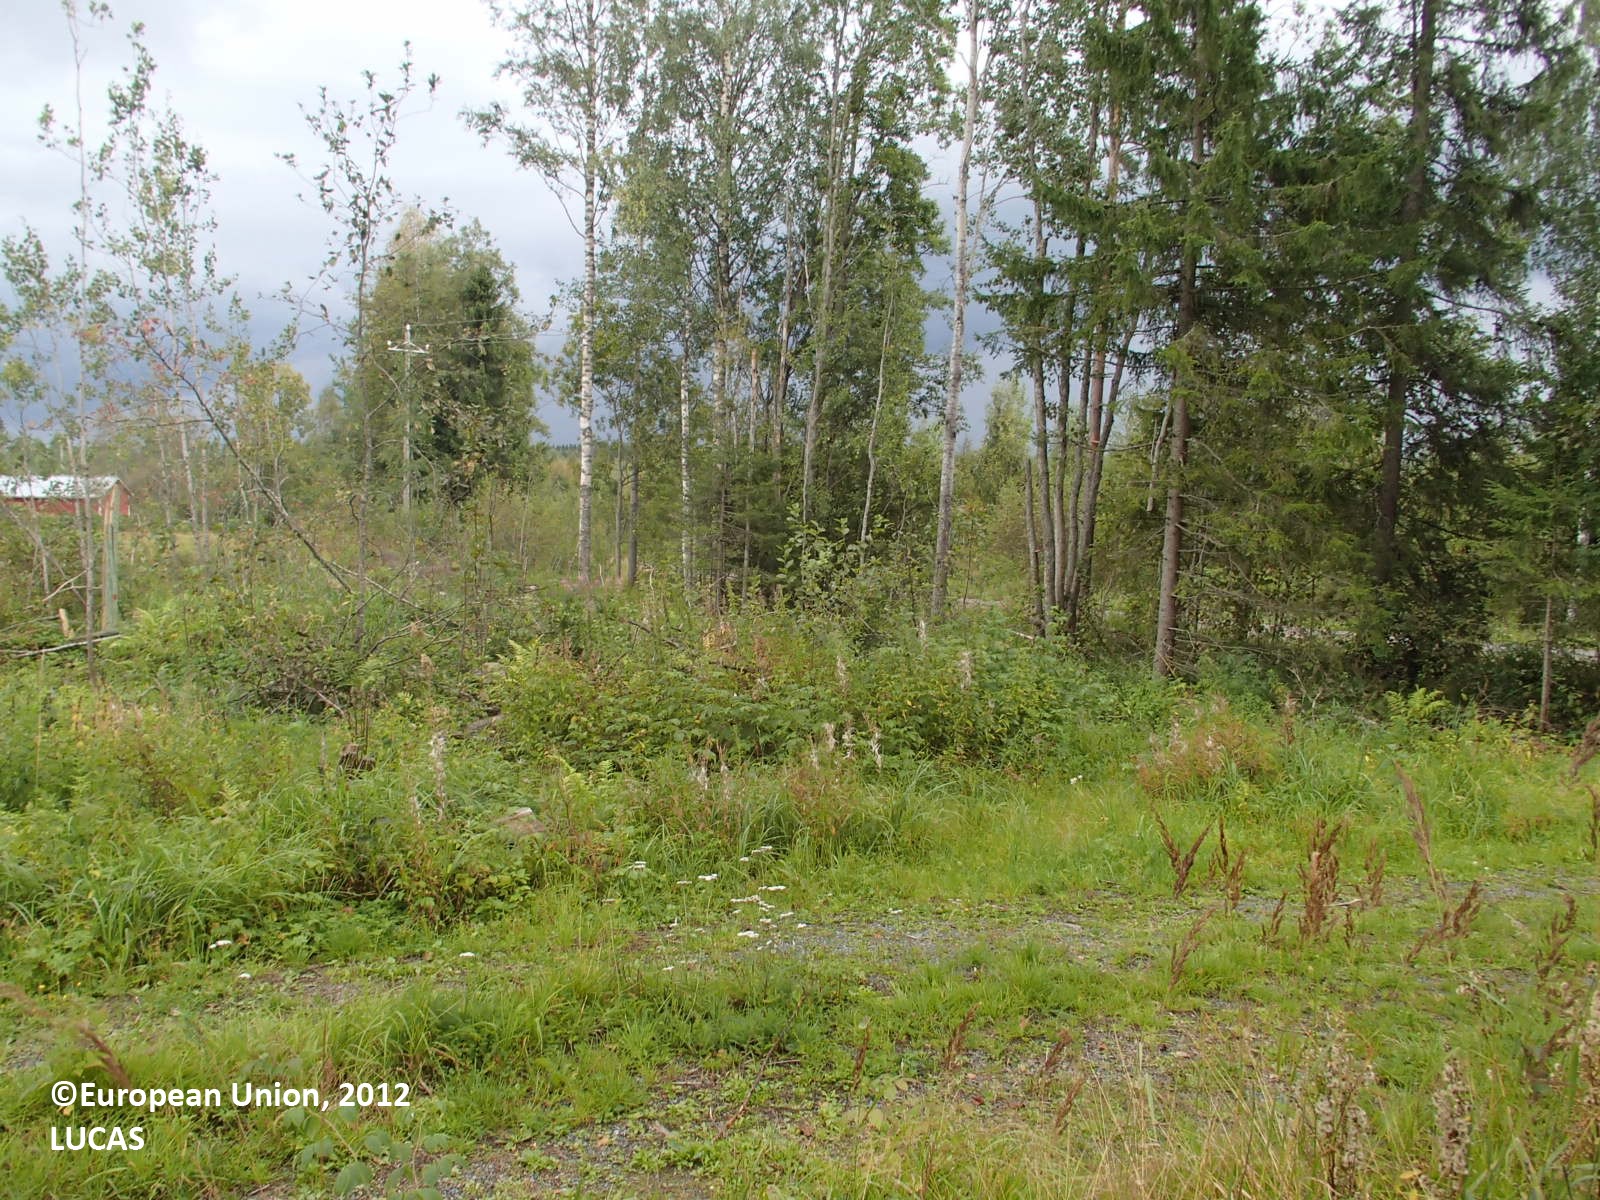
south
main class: Woodland
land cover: Spruce dominated mixed woodland
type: boreal forest
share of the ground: > 75 %
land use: Forestry
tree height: > 5 m
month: August
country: FI
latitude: 63.4769
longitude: 27.1046
